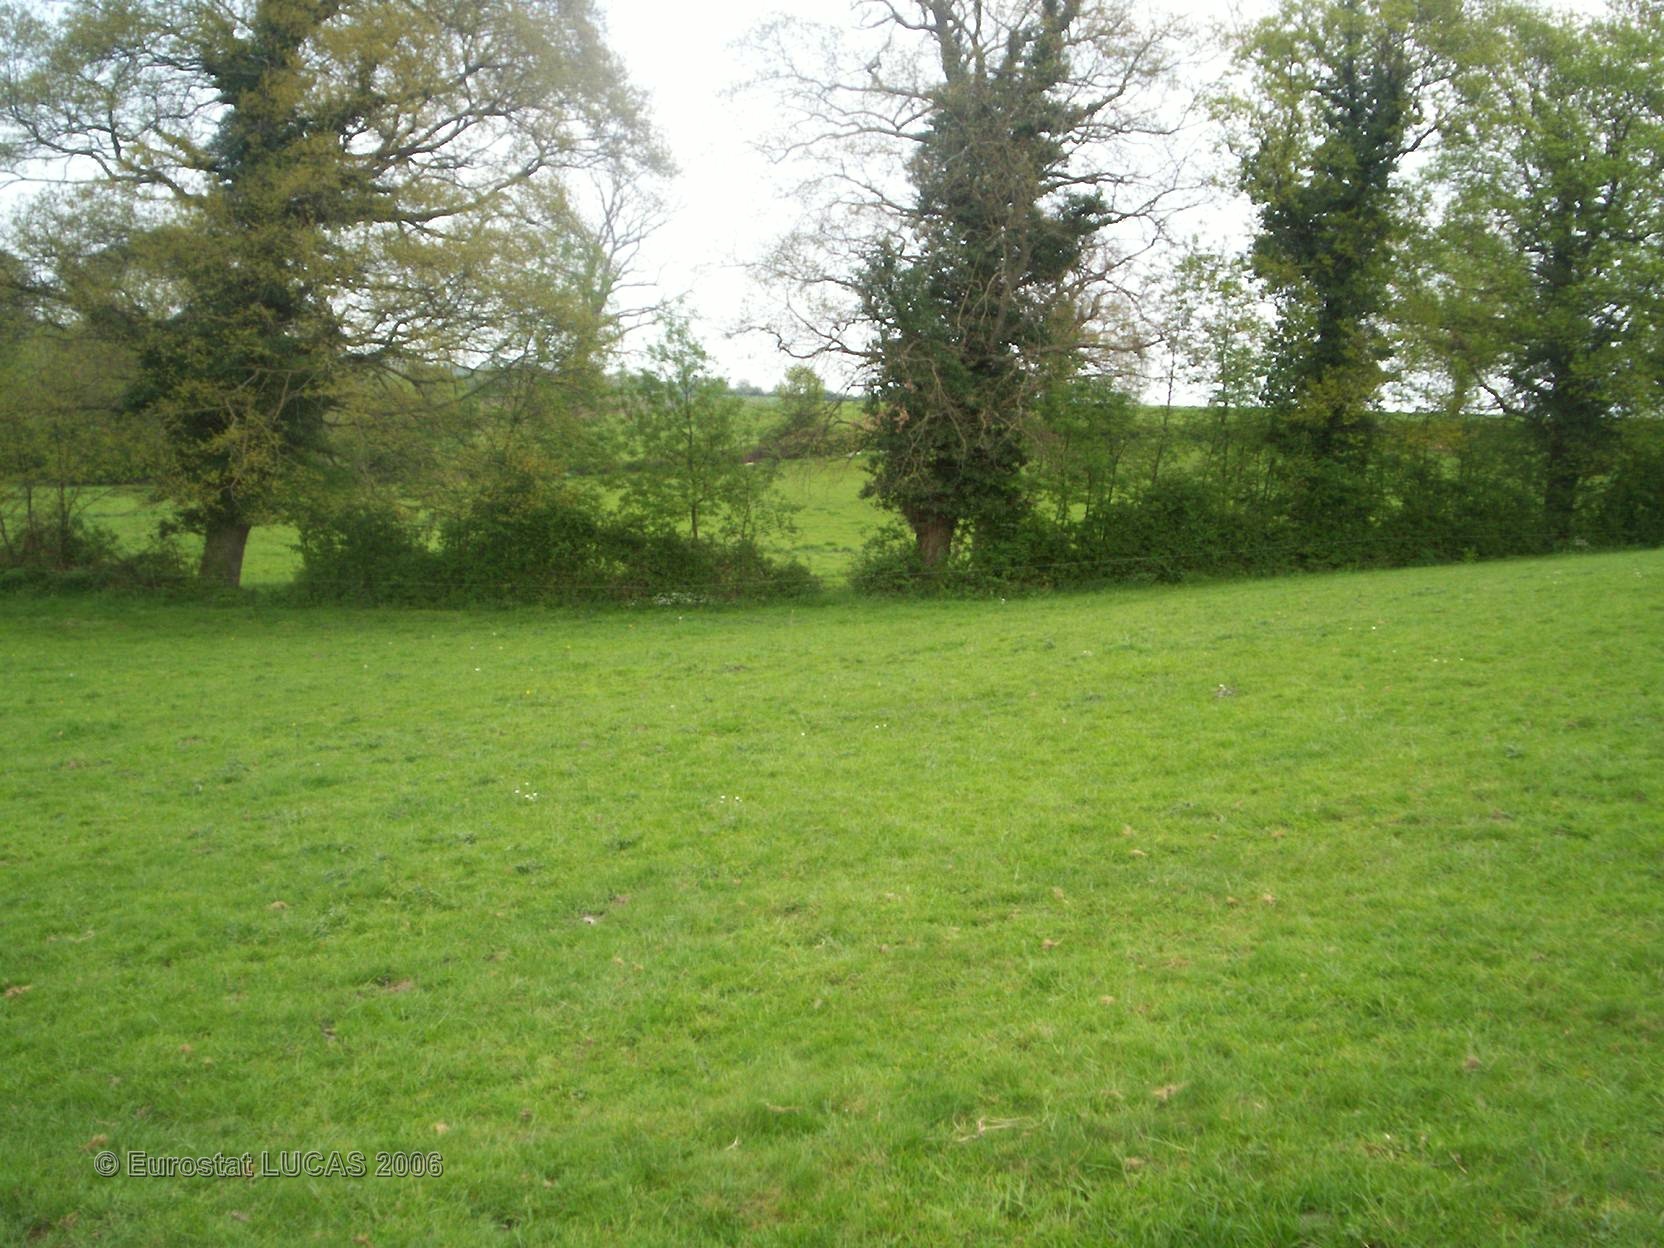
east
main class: Grassland
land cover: Grassland without tree/shrub cover
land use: Agriculture (excluding fallow land and kitchen gardens)
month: May
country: FR
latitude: 46.4901
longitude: 3.1058
